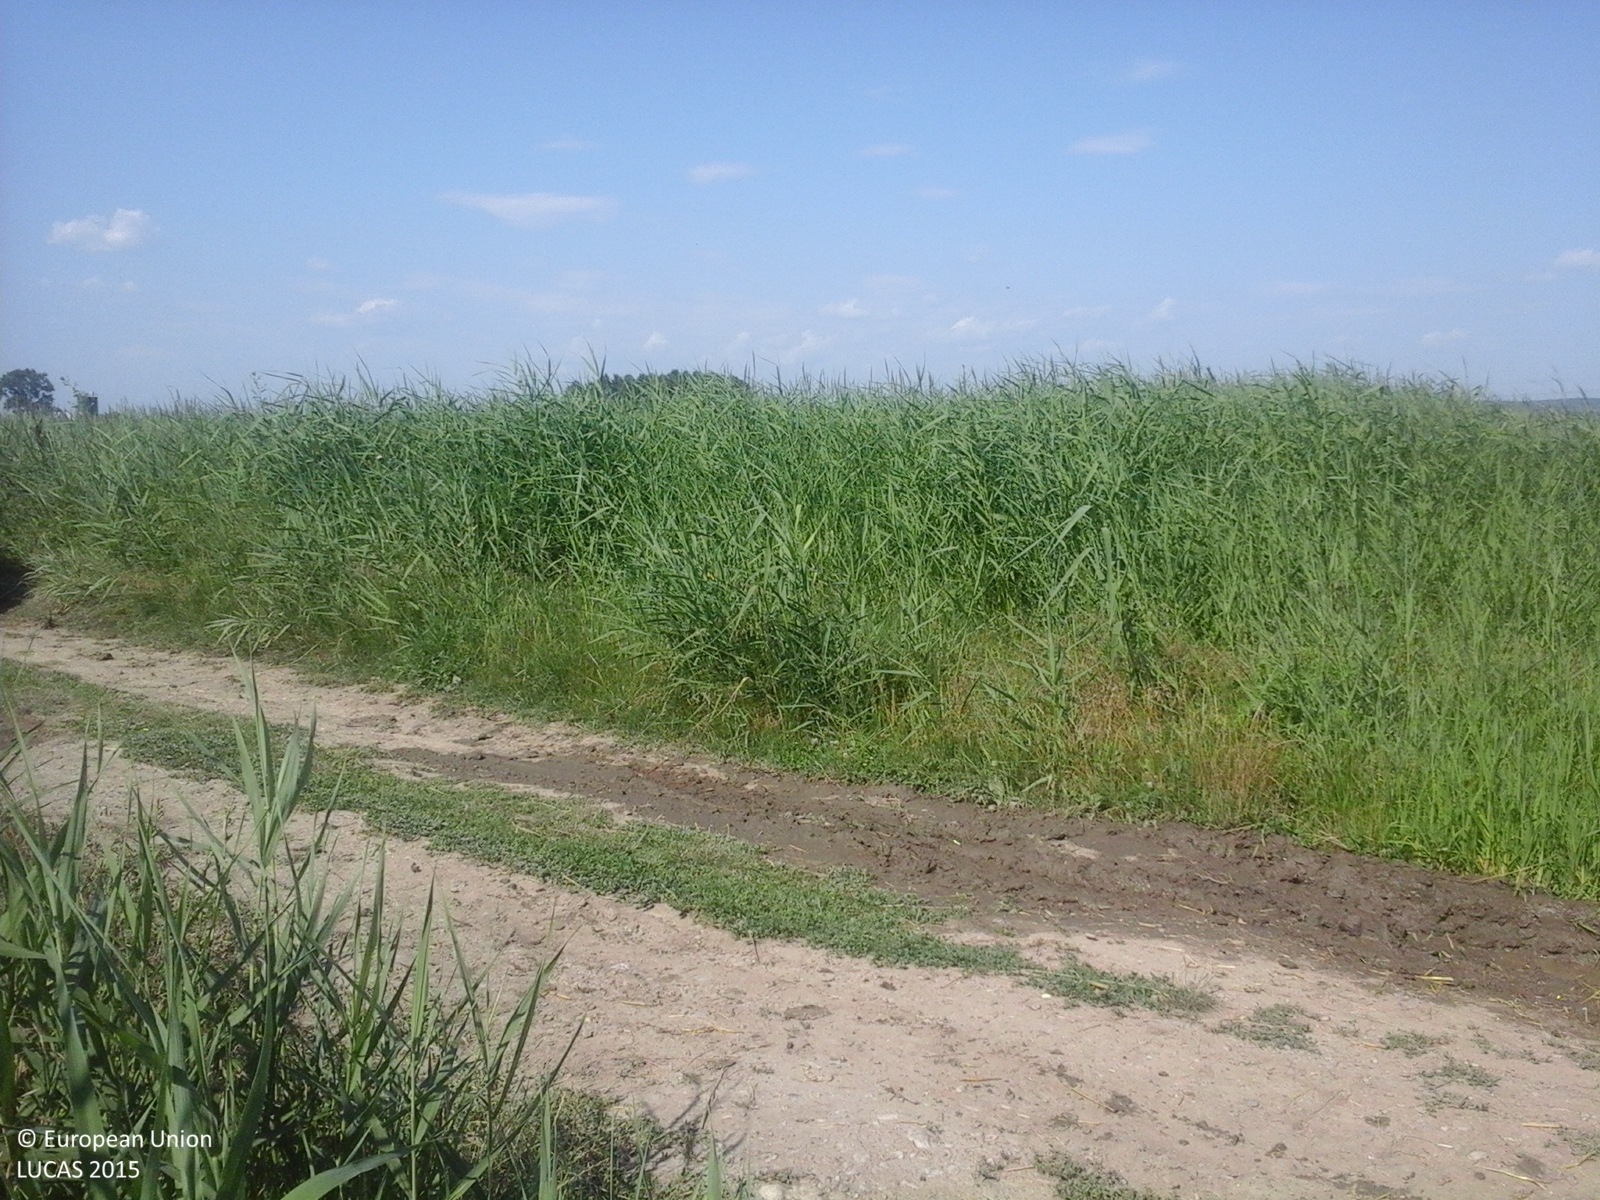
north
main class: Cropland
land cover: Maize
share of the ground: > 75 %
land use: Agriculture (excluding fallow land and kitchen gardens)
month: July
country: RO
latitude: 44.6556
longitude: 24.2804
